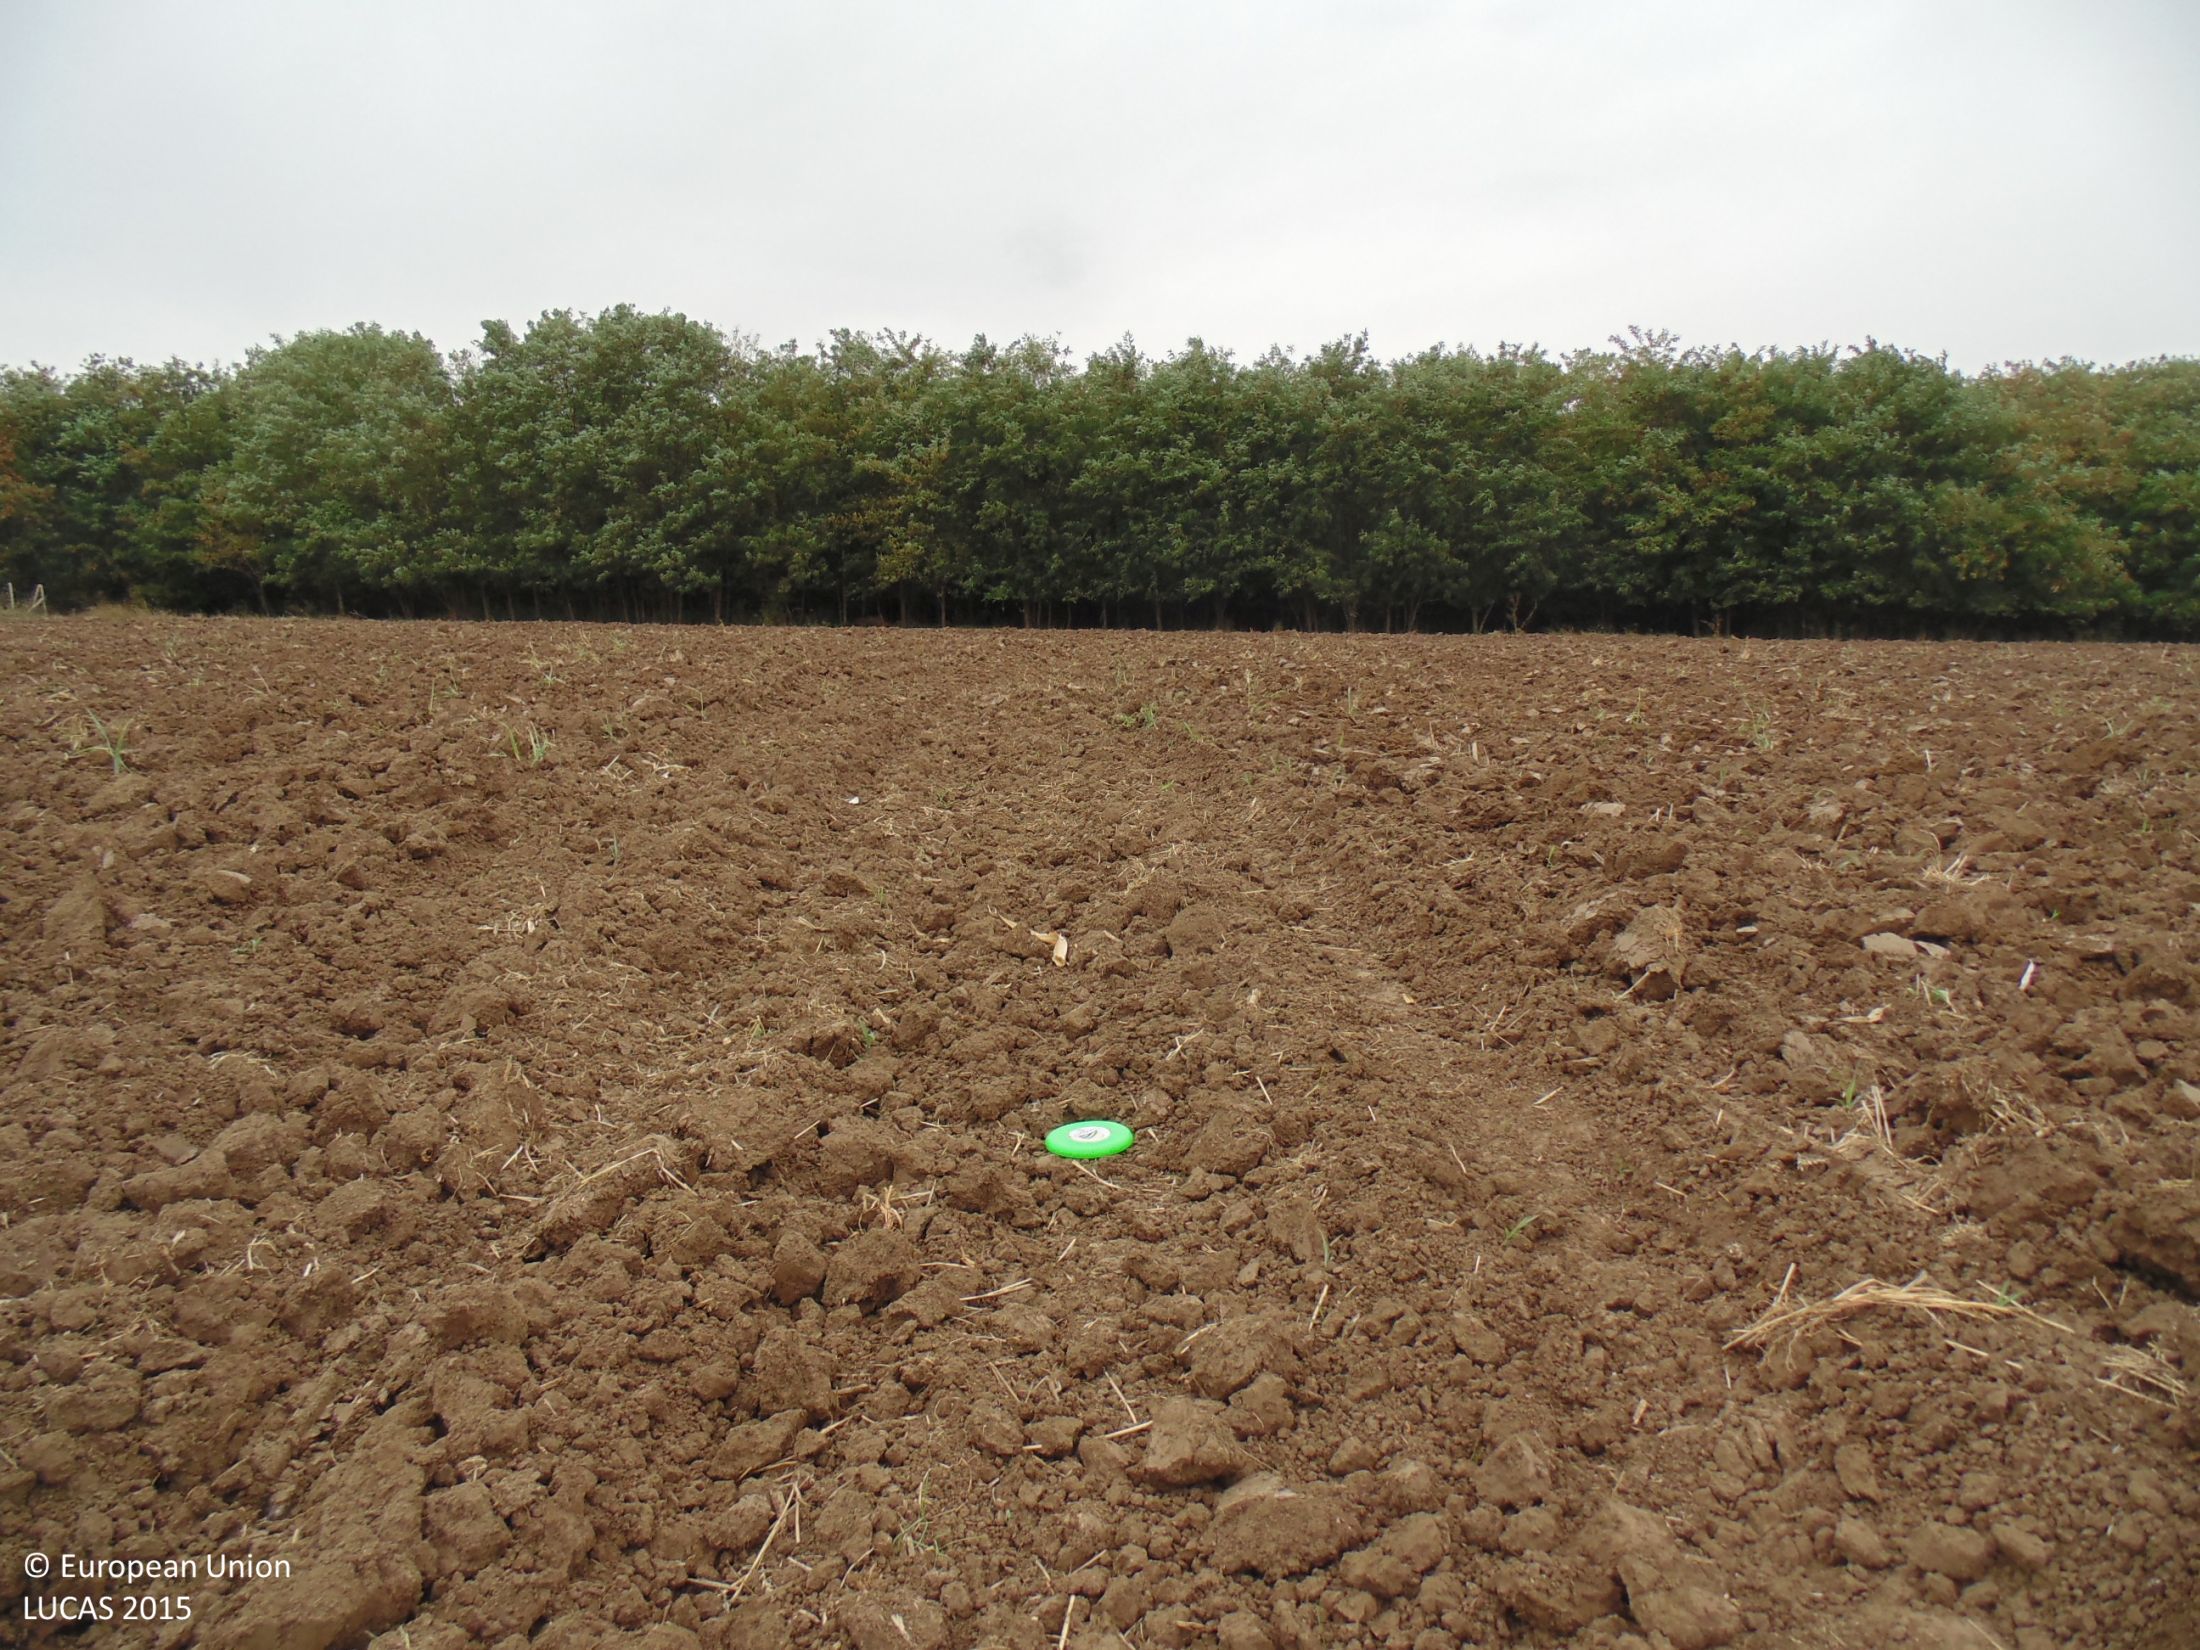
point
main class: Cropland
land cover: Common wheat
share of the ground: < 10 %
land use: Agriculture (excluding fallow land and kitchen gardens)
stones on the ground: < 10 %
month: September
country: BG
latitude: 43.9504
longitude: 26.9813
